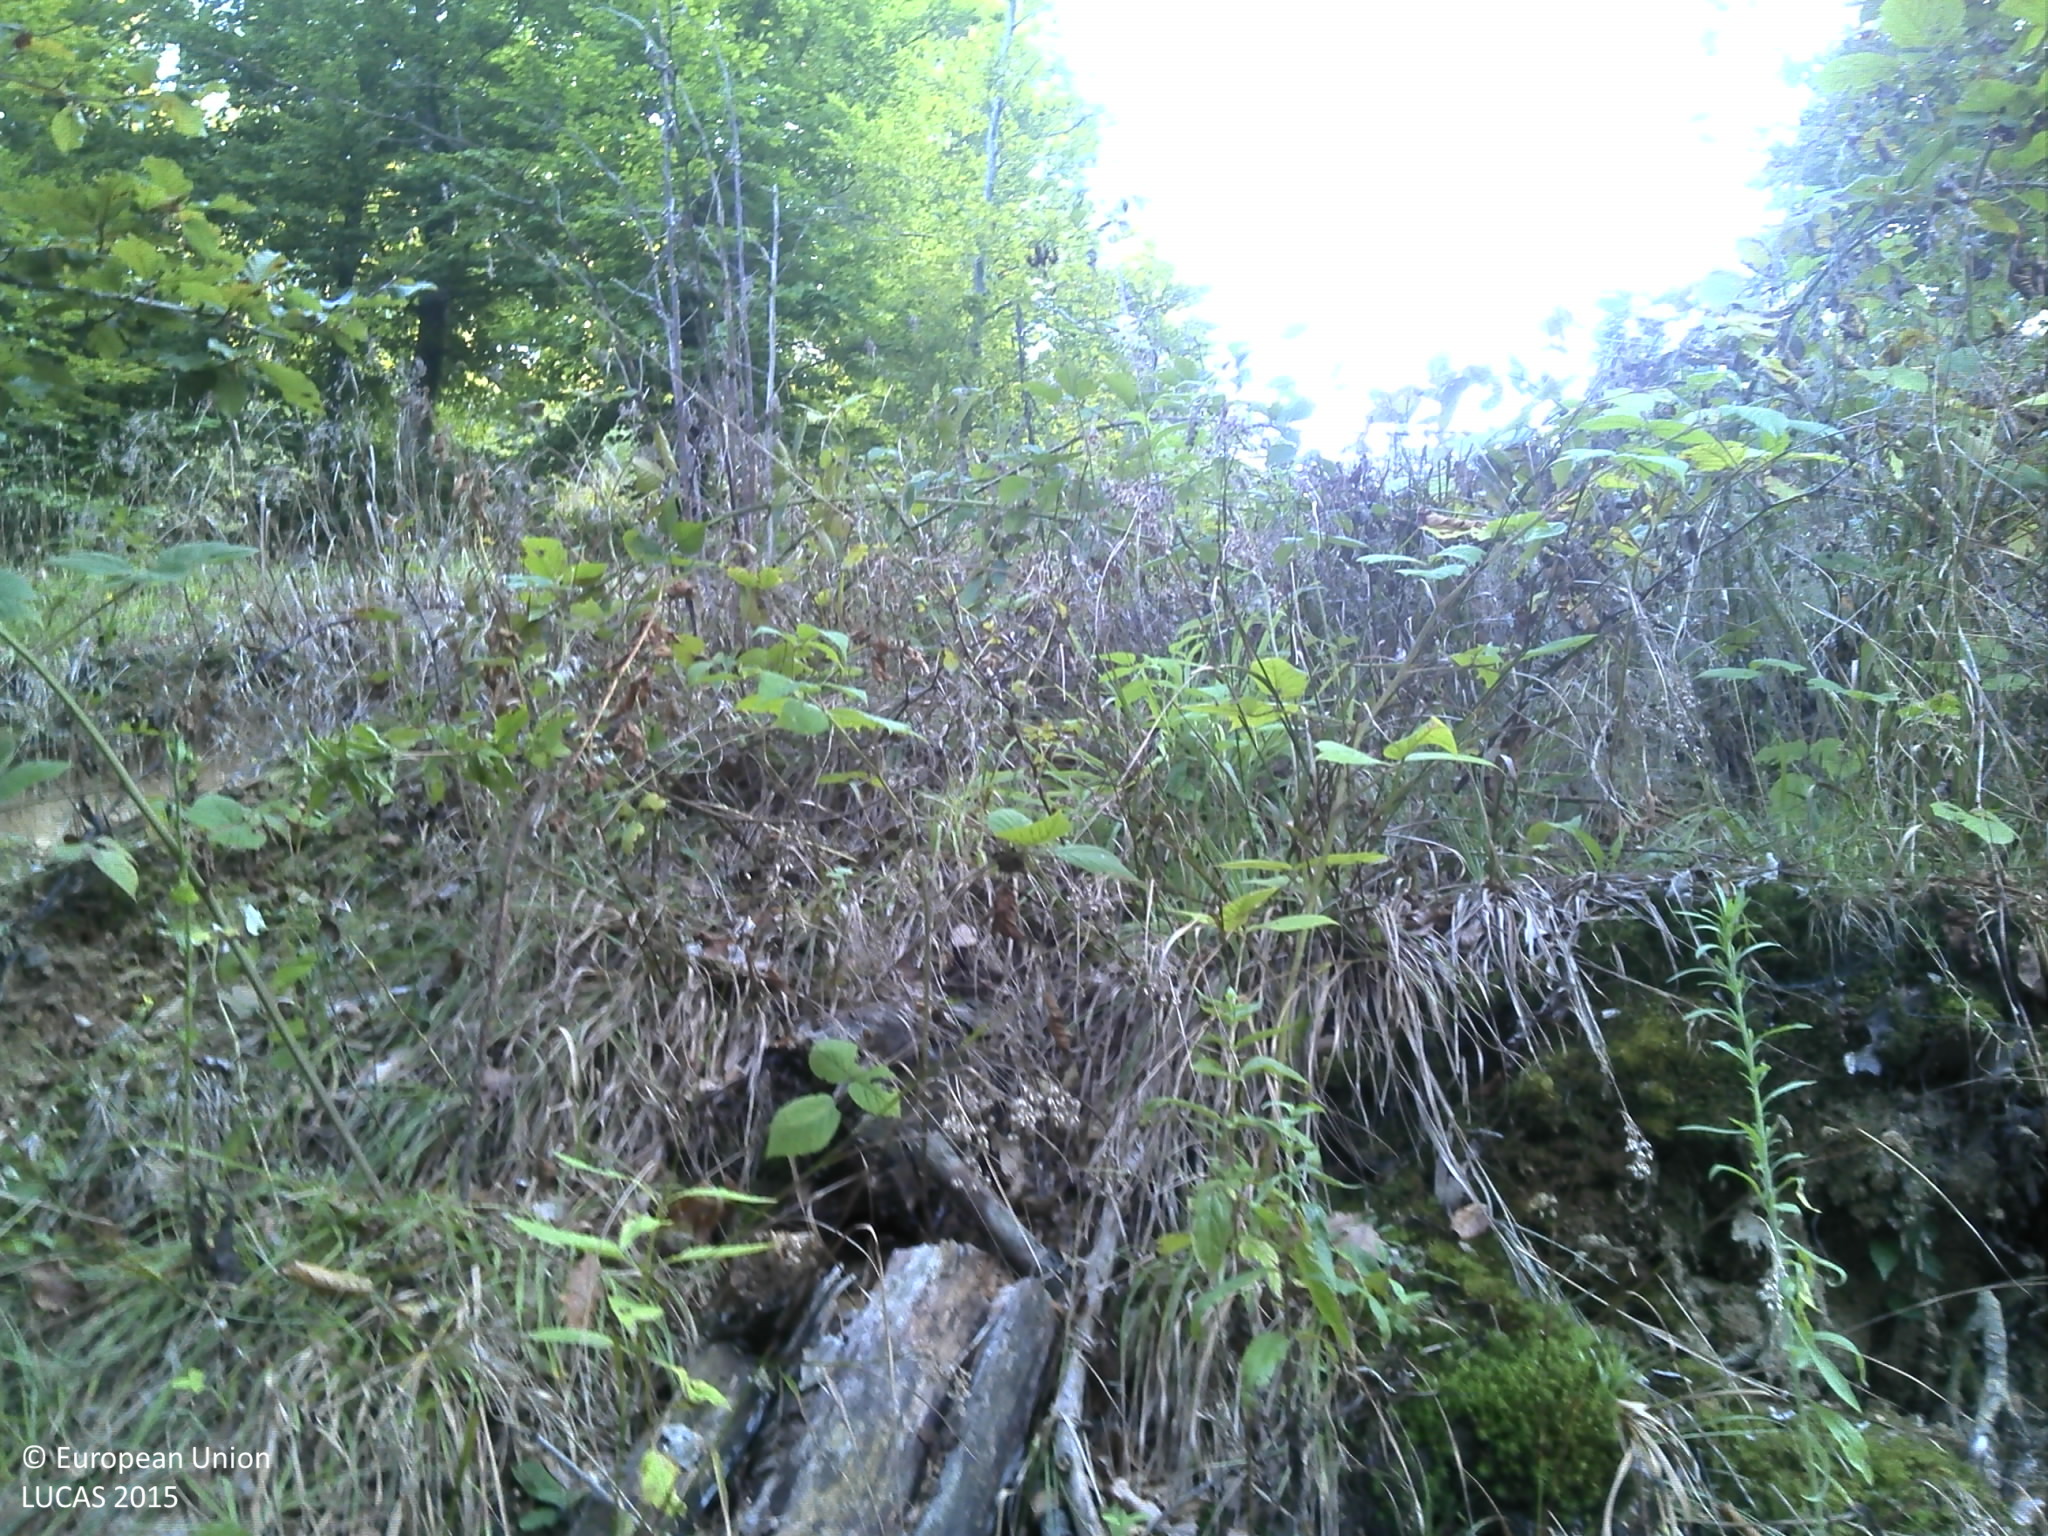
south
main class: Woodland
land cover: Broadleaved woodland
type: acidophilous oak and oak-birch forest
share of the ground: 25 - 50 %
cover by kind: herbaceous plants 45 %, broadleaved forest trees 30 %, shrubs 25 %
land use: Forestry
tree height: > 5 m
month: August
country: HR
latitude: 45.2781
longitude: 16.3327
